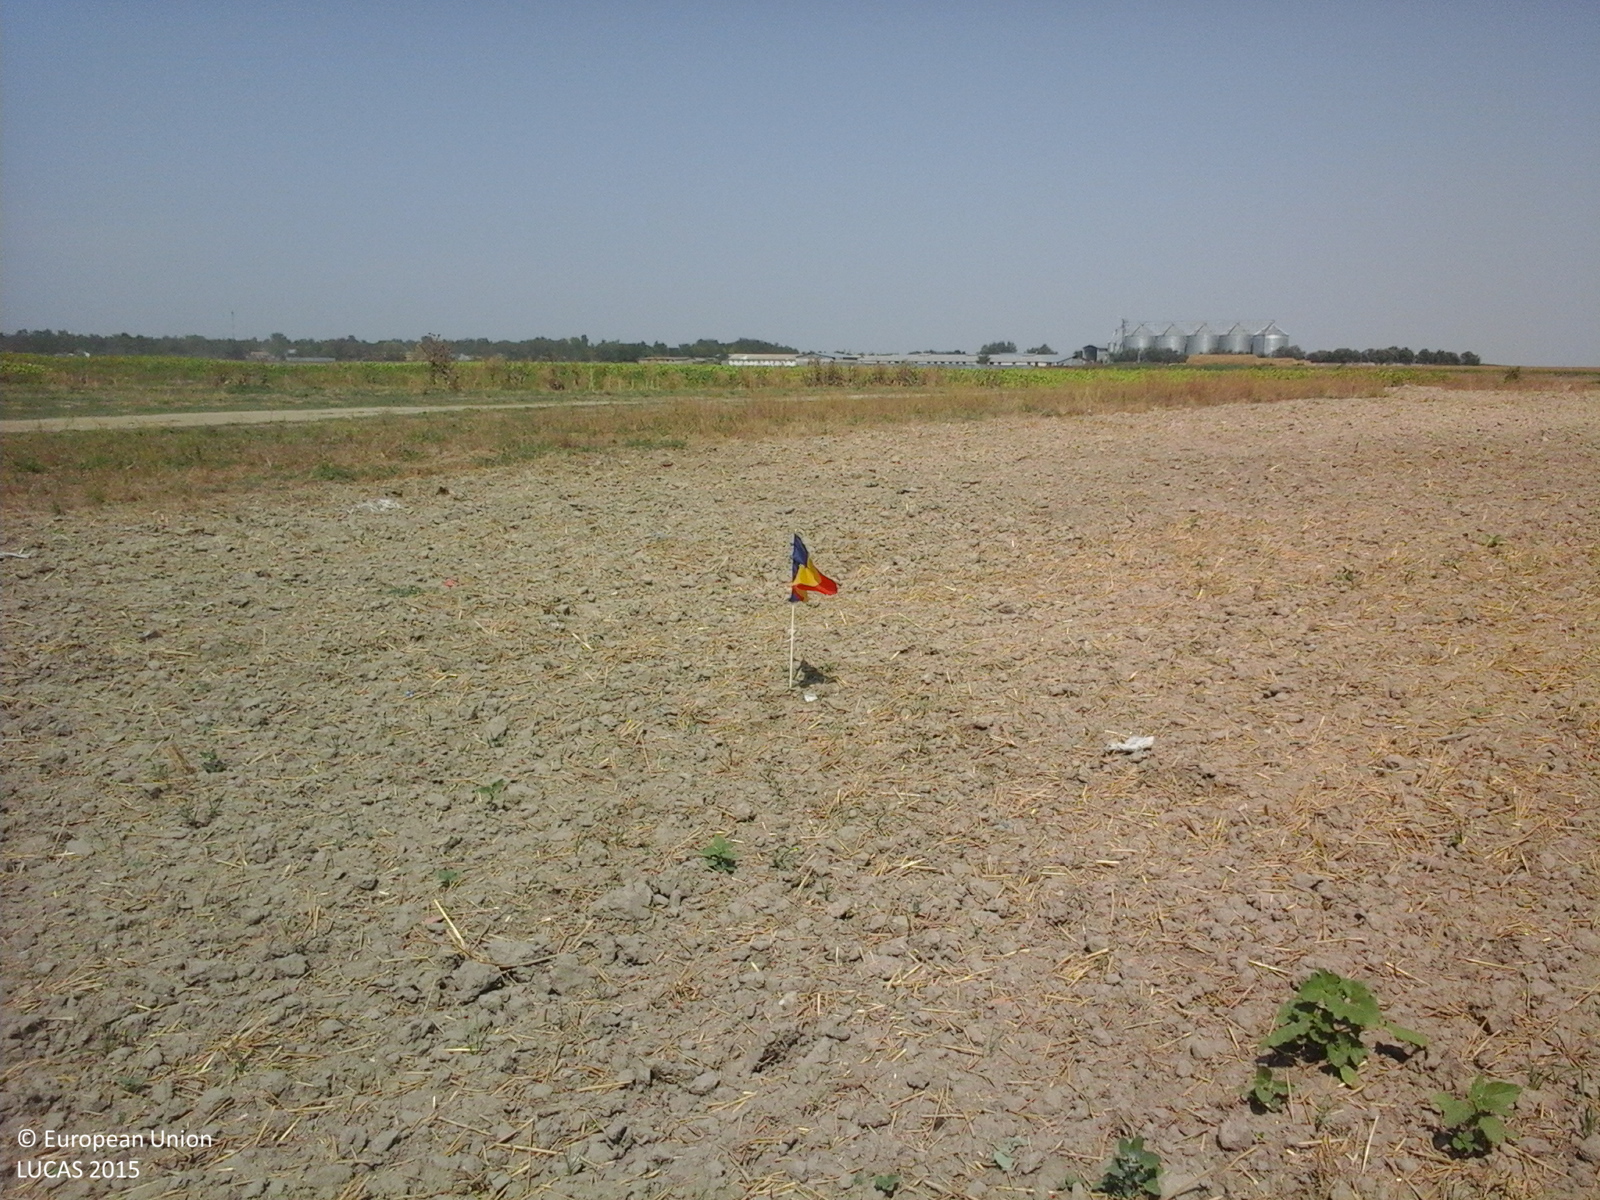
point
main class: Cropland
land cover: Common wheat
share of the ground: < 10 %
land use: Agriculture (excluding fallow land and kitchen gardens)
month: August
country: RO
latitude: 45.2772
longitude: 27.7372
